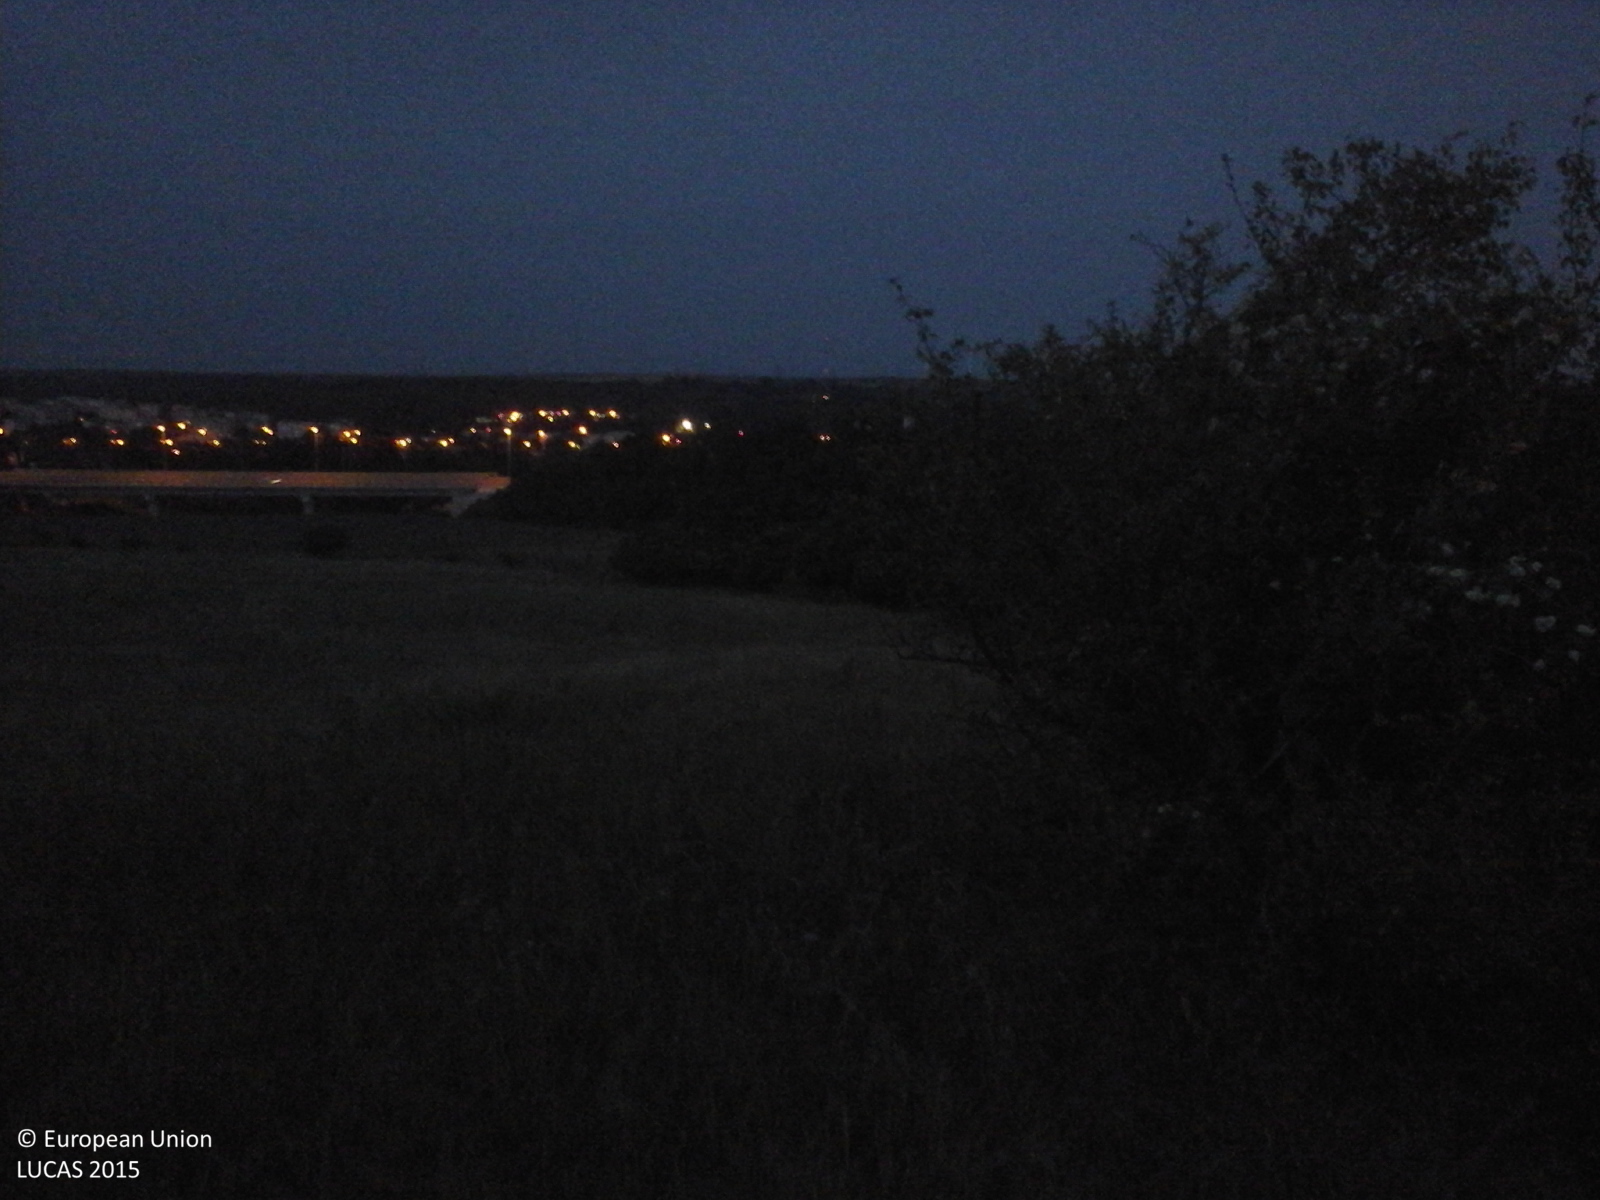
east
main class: Cropland
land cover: Vineyards
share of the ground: > 75 %
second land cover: Shrubland without tree cover
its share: > 75 %
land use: Abandoned areas
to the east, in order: Vineyards; Shrubland without tree cover
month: August
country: RO
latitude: 44.3239
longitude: 28.0251
